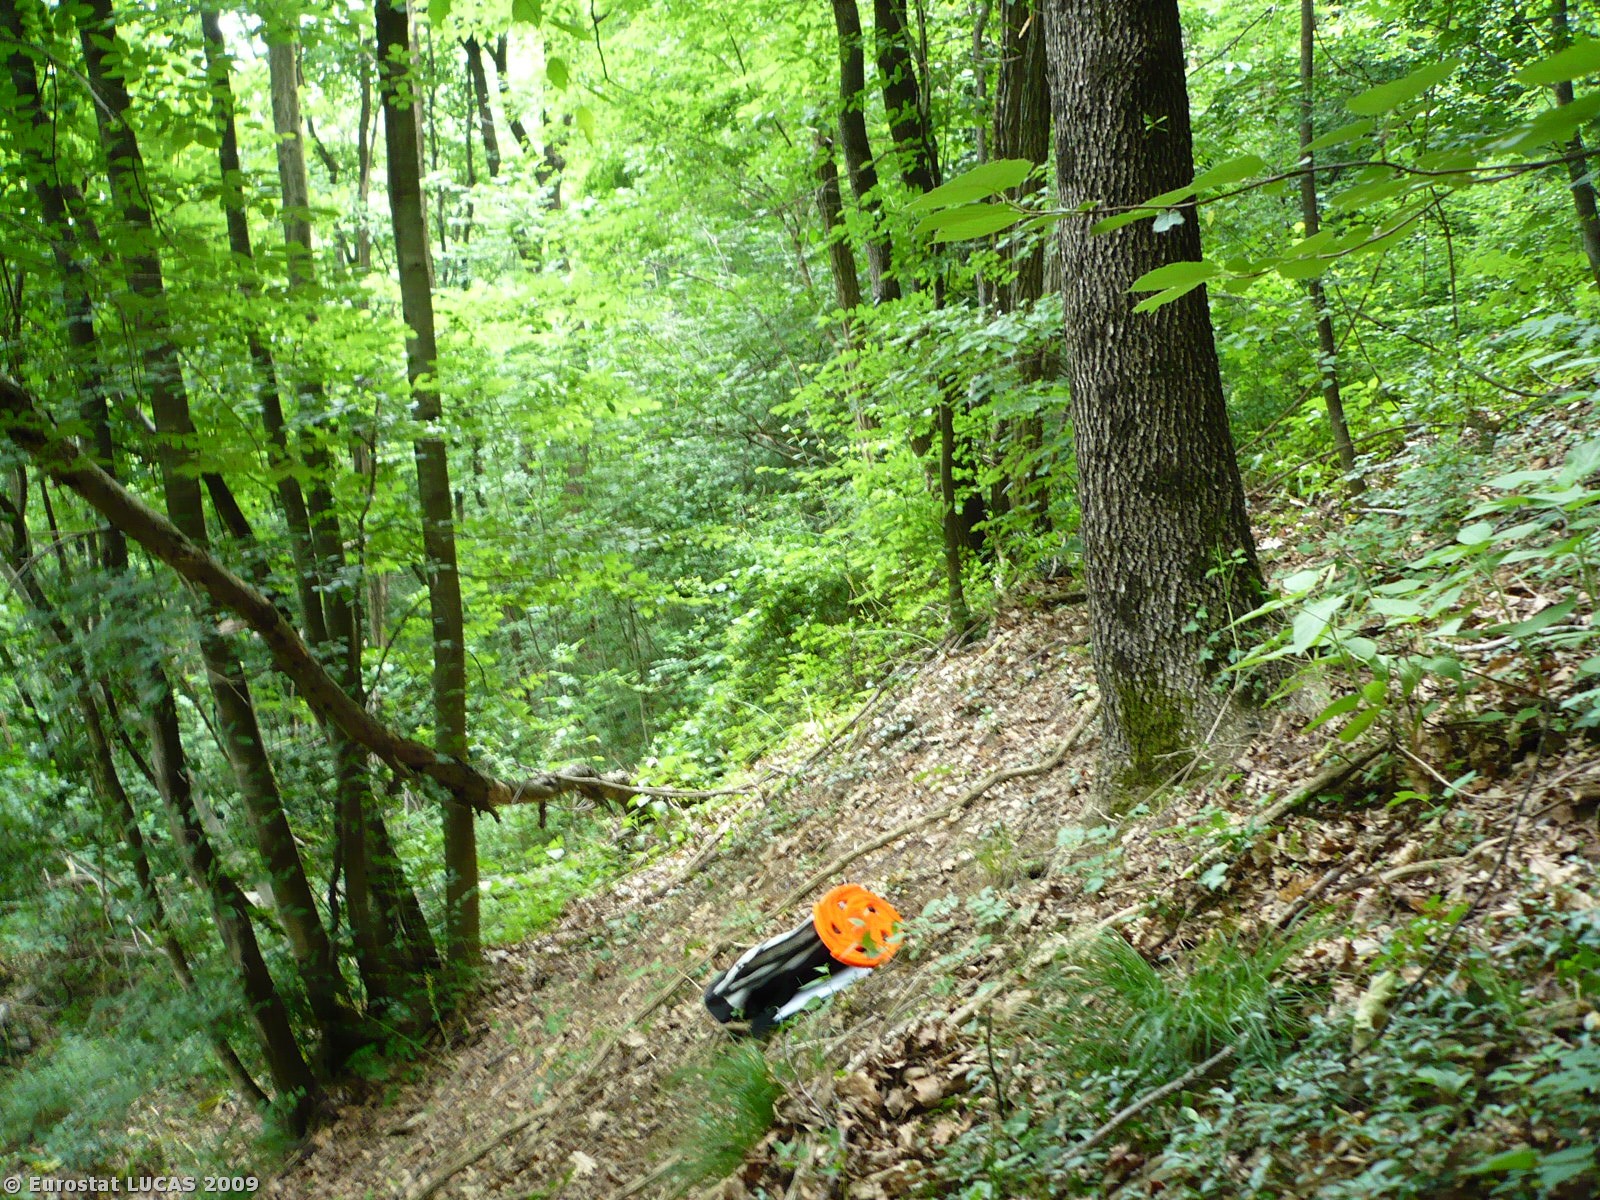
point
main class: Woodland
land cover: Broadleaved woodland
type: beech forest
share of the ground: > 75 %
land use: Unused
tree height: > 5 m
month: June
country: SI
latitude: 46.1084
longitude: 13.6578
